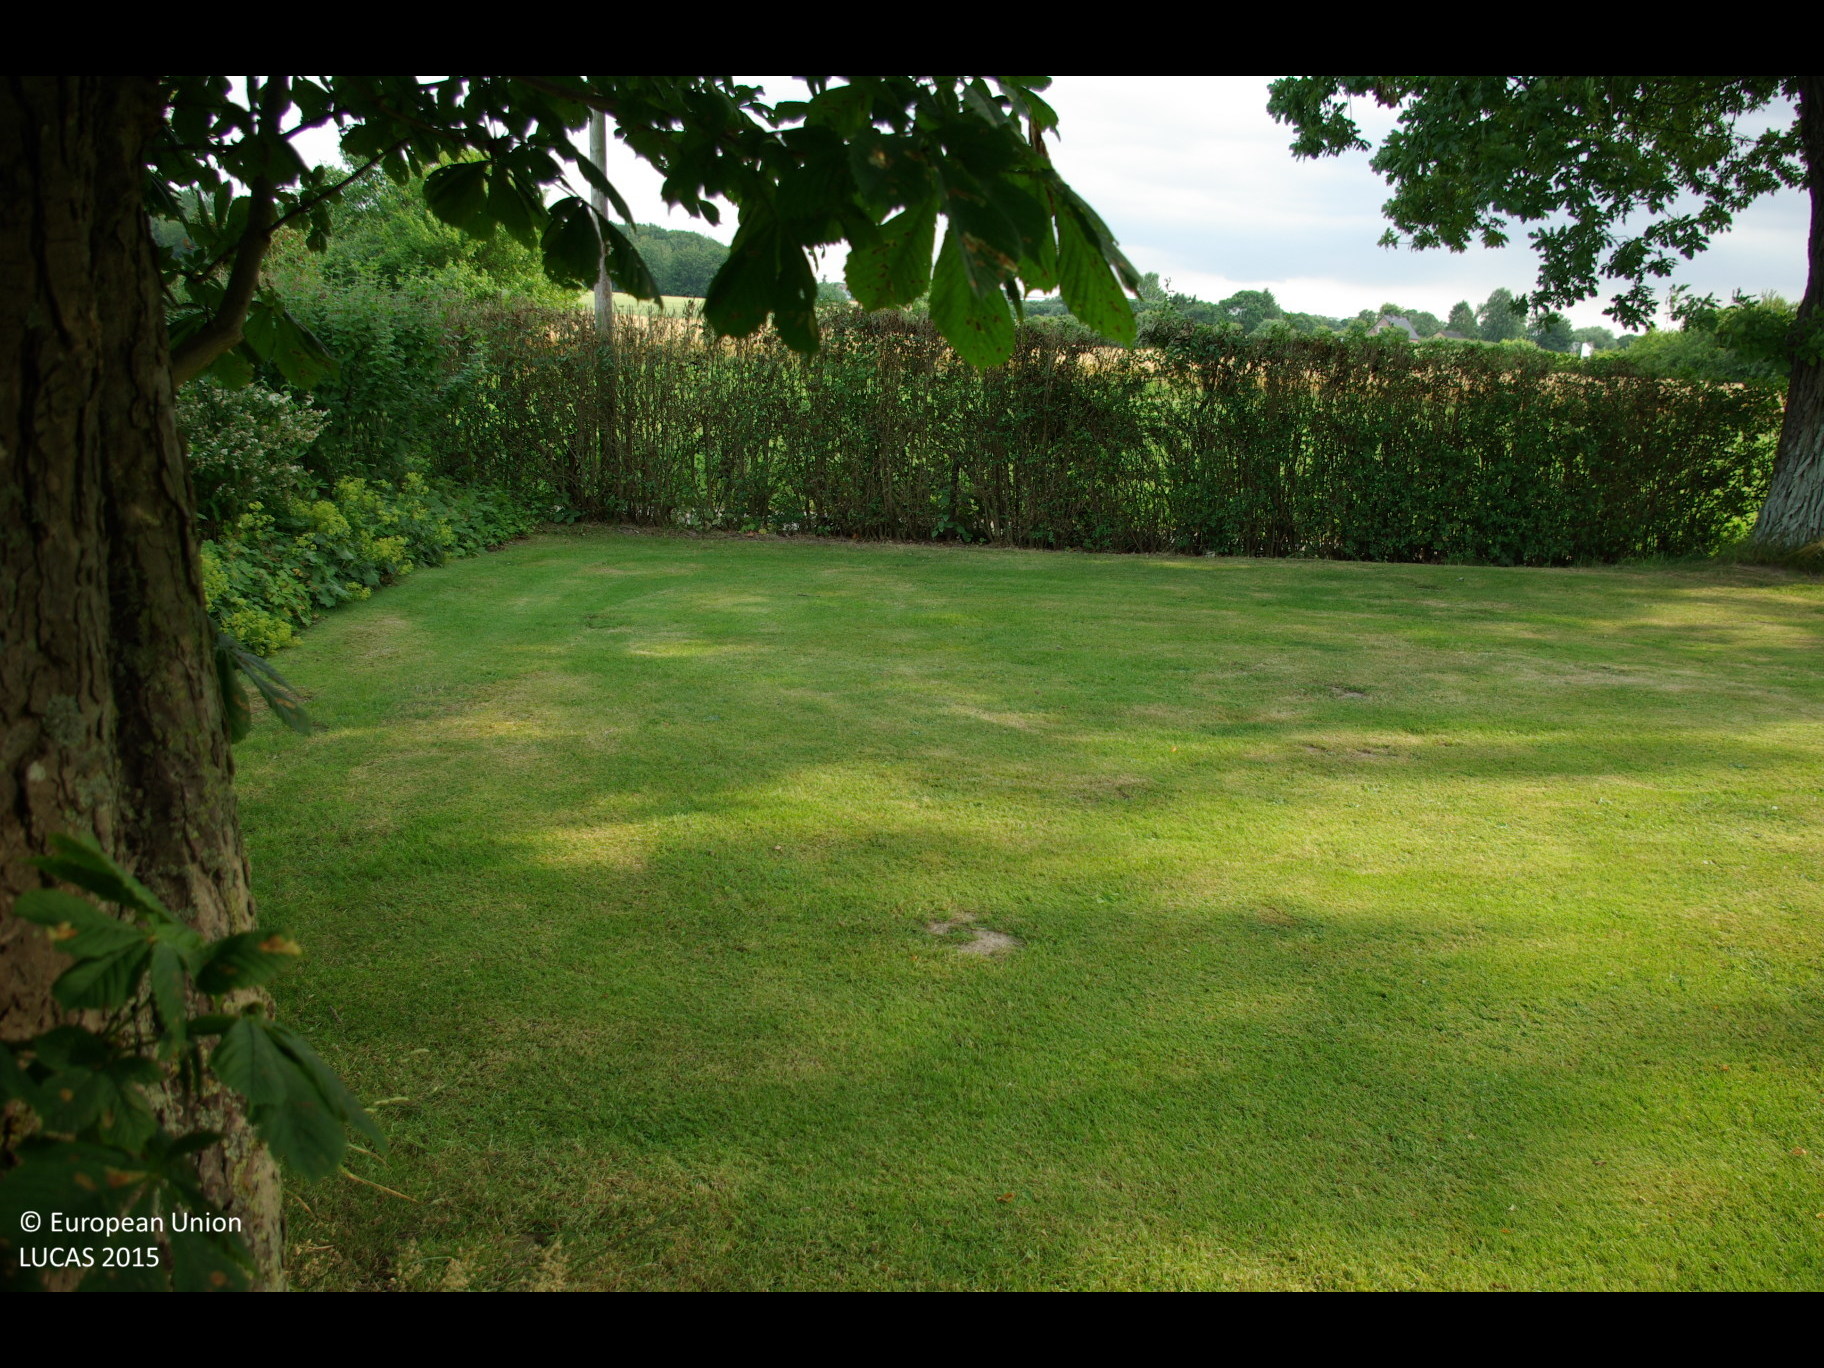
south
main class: Woodland
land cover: Broadleaved woodland
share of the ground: 50 - 75 %
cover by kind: broadleaved forest trees 50 %, herbaceous plants 50 %
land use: Residential
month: July
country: DE
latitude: 54.6779
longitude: 9.9225
